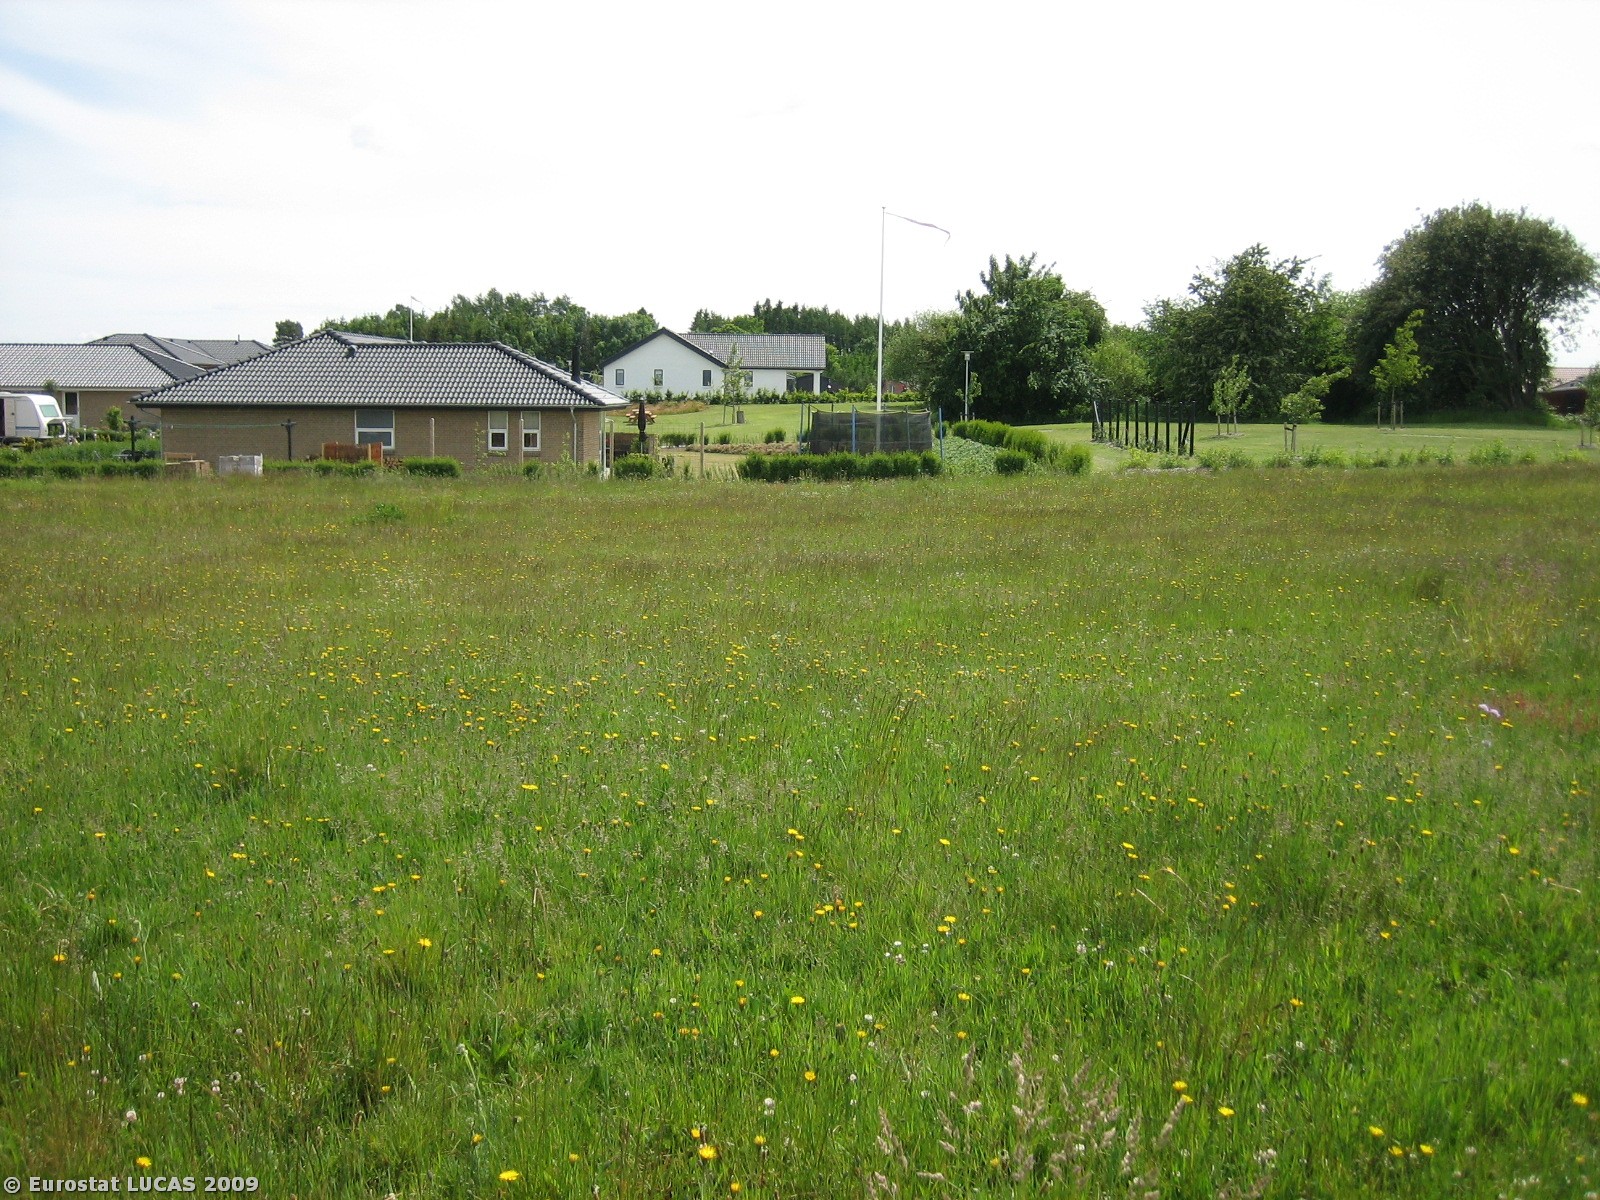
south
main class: Grassland
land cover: Grassland without tree/shrub cover
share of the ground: > 75 %
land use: Unused
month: June
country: DK
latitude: 56.1874
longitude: 9.6942
